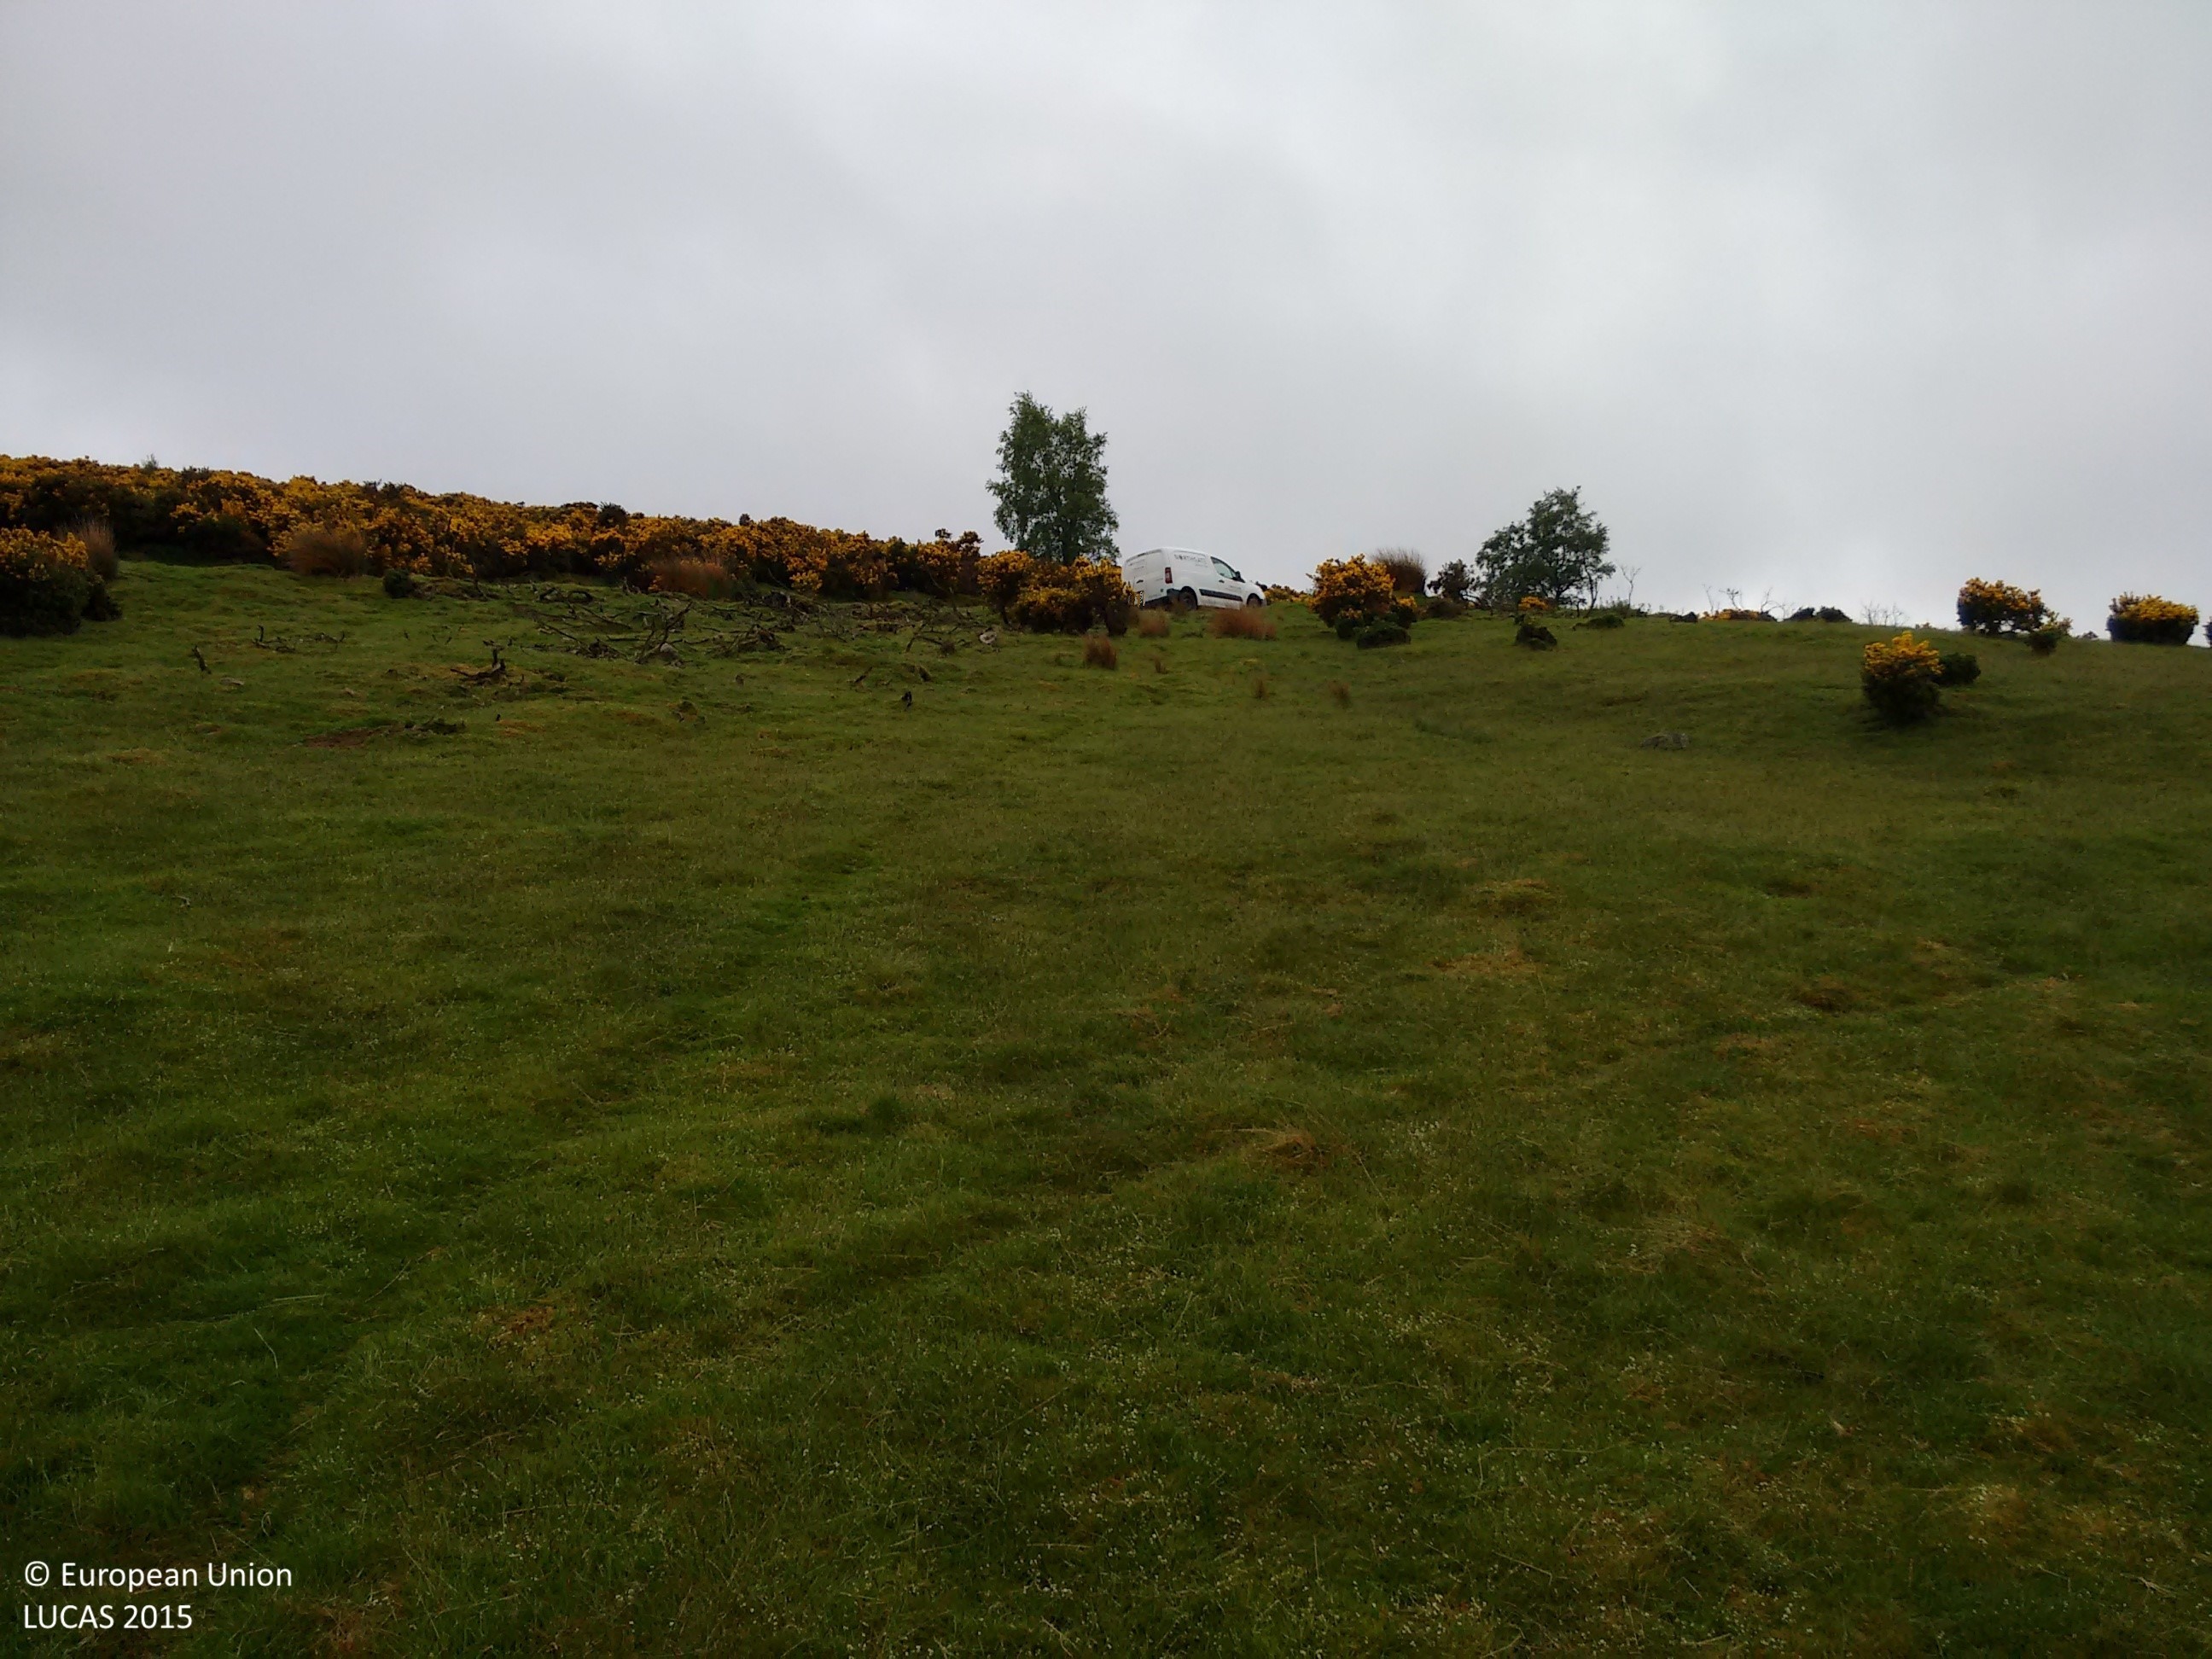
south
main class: Grassland
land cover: Grassland without tree/shrub cover
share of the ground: > 75 %
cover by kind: herbaceous plants 95 %, shrubs 5 %
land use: Agriculture (excluding fallow land and kitchen gardens)
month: June
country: GB
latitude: 57.0243
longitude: -2.7603
